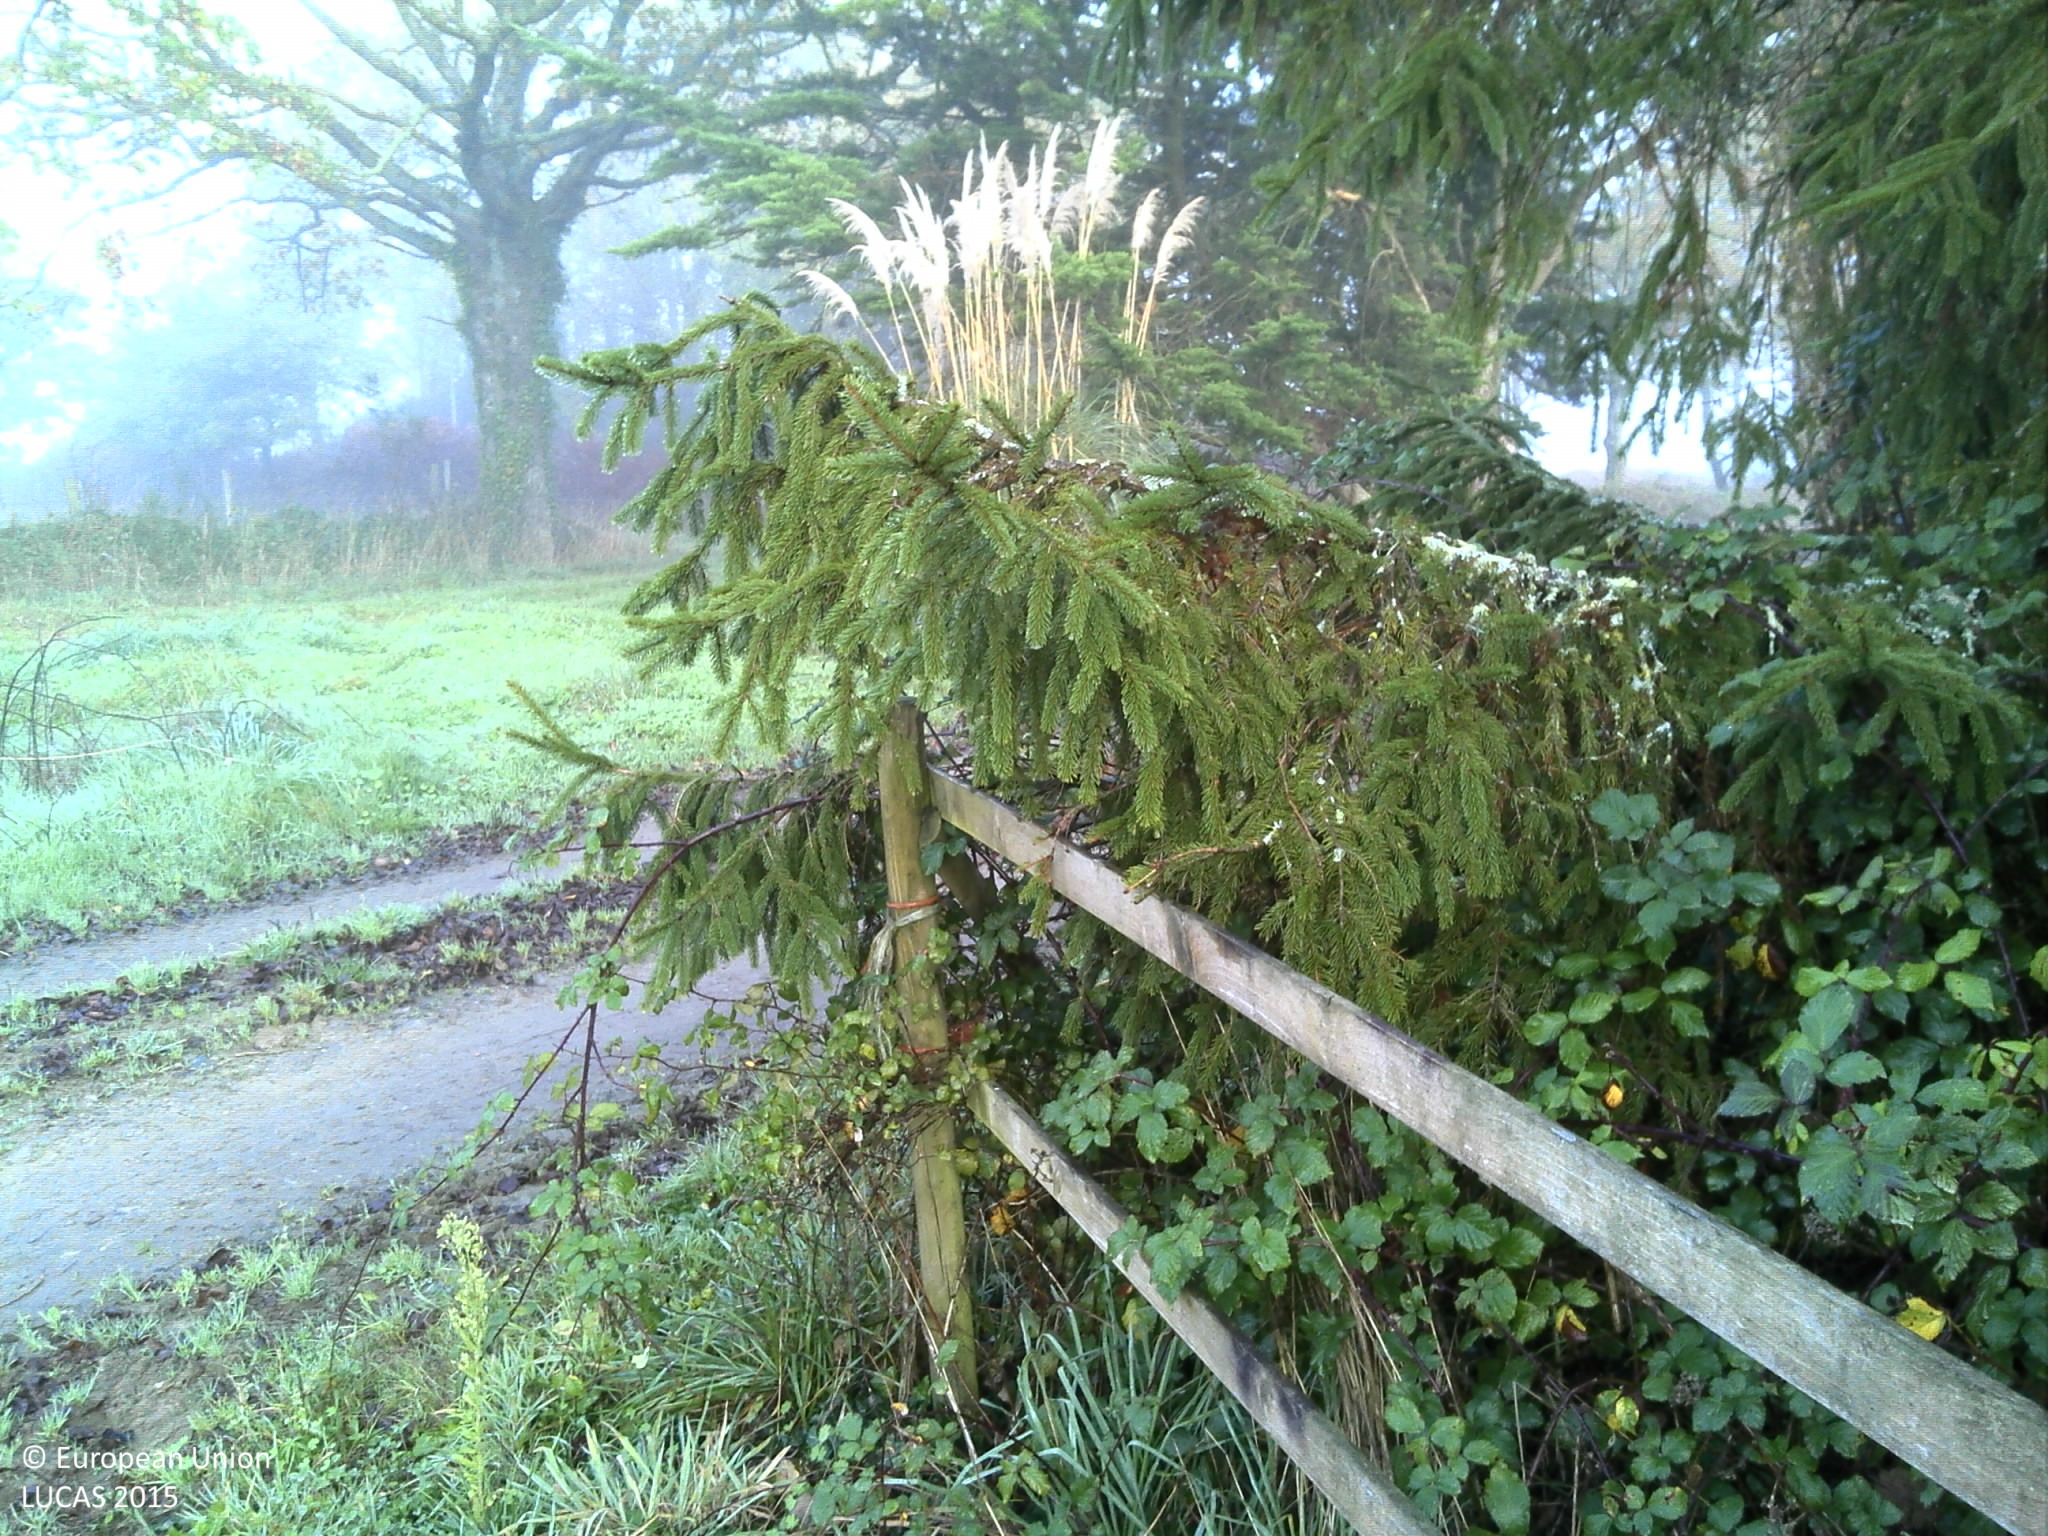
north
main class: Grassland
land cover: Grassland with sparse tree/shrub cover
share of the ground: > 75 %
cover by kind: herbaceous plants 95 %, coniferous forest trees 5 %
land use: Residential
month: November
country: FR
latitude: 47.3493
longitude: -1.8144
